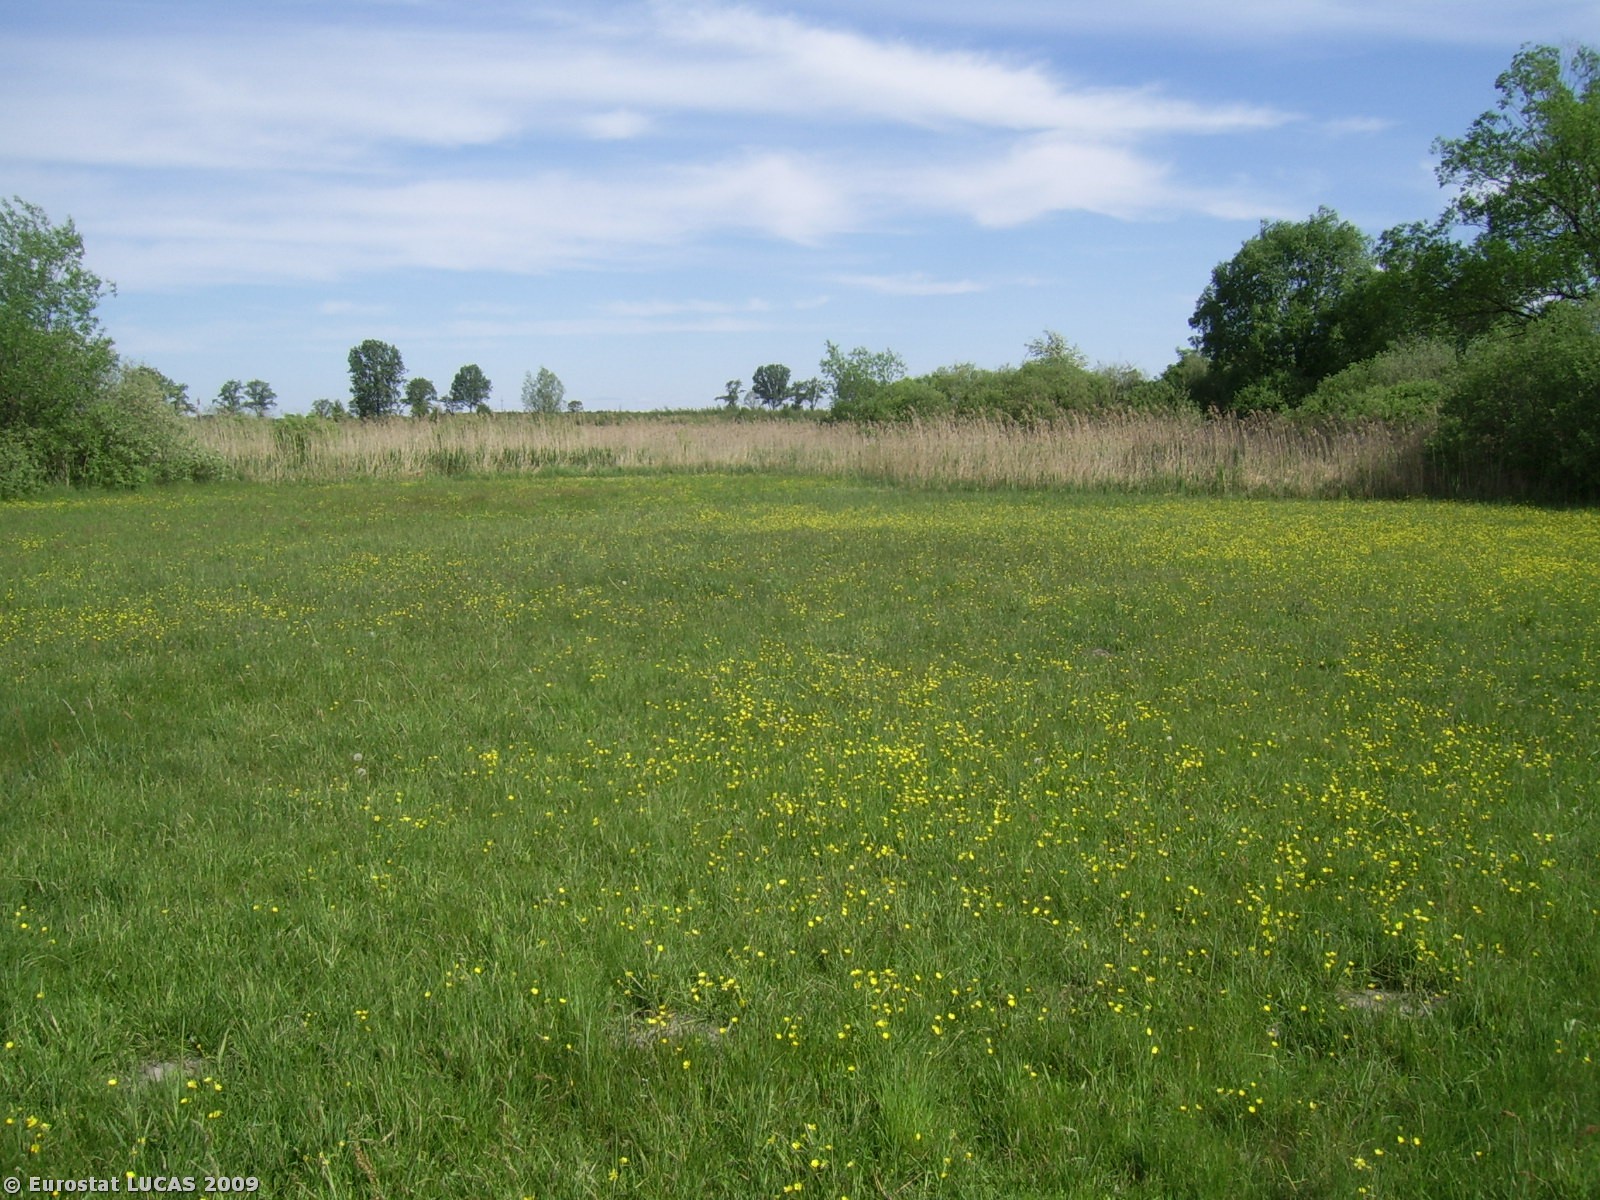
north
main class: Grassland
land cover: Grassland without tree/shrub cover
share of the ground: > 75 %
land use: Agriculture (excluding fallow land and kitchen gardens)
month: May
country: PL
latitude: 52.0142
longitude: 16.9013
